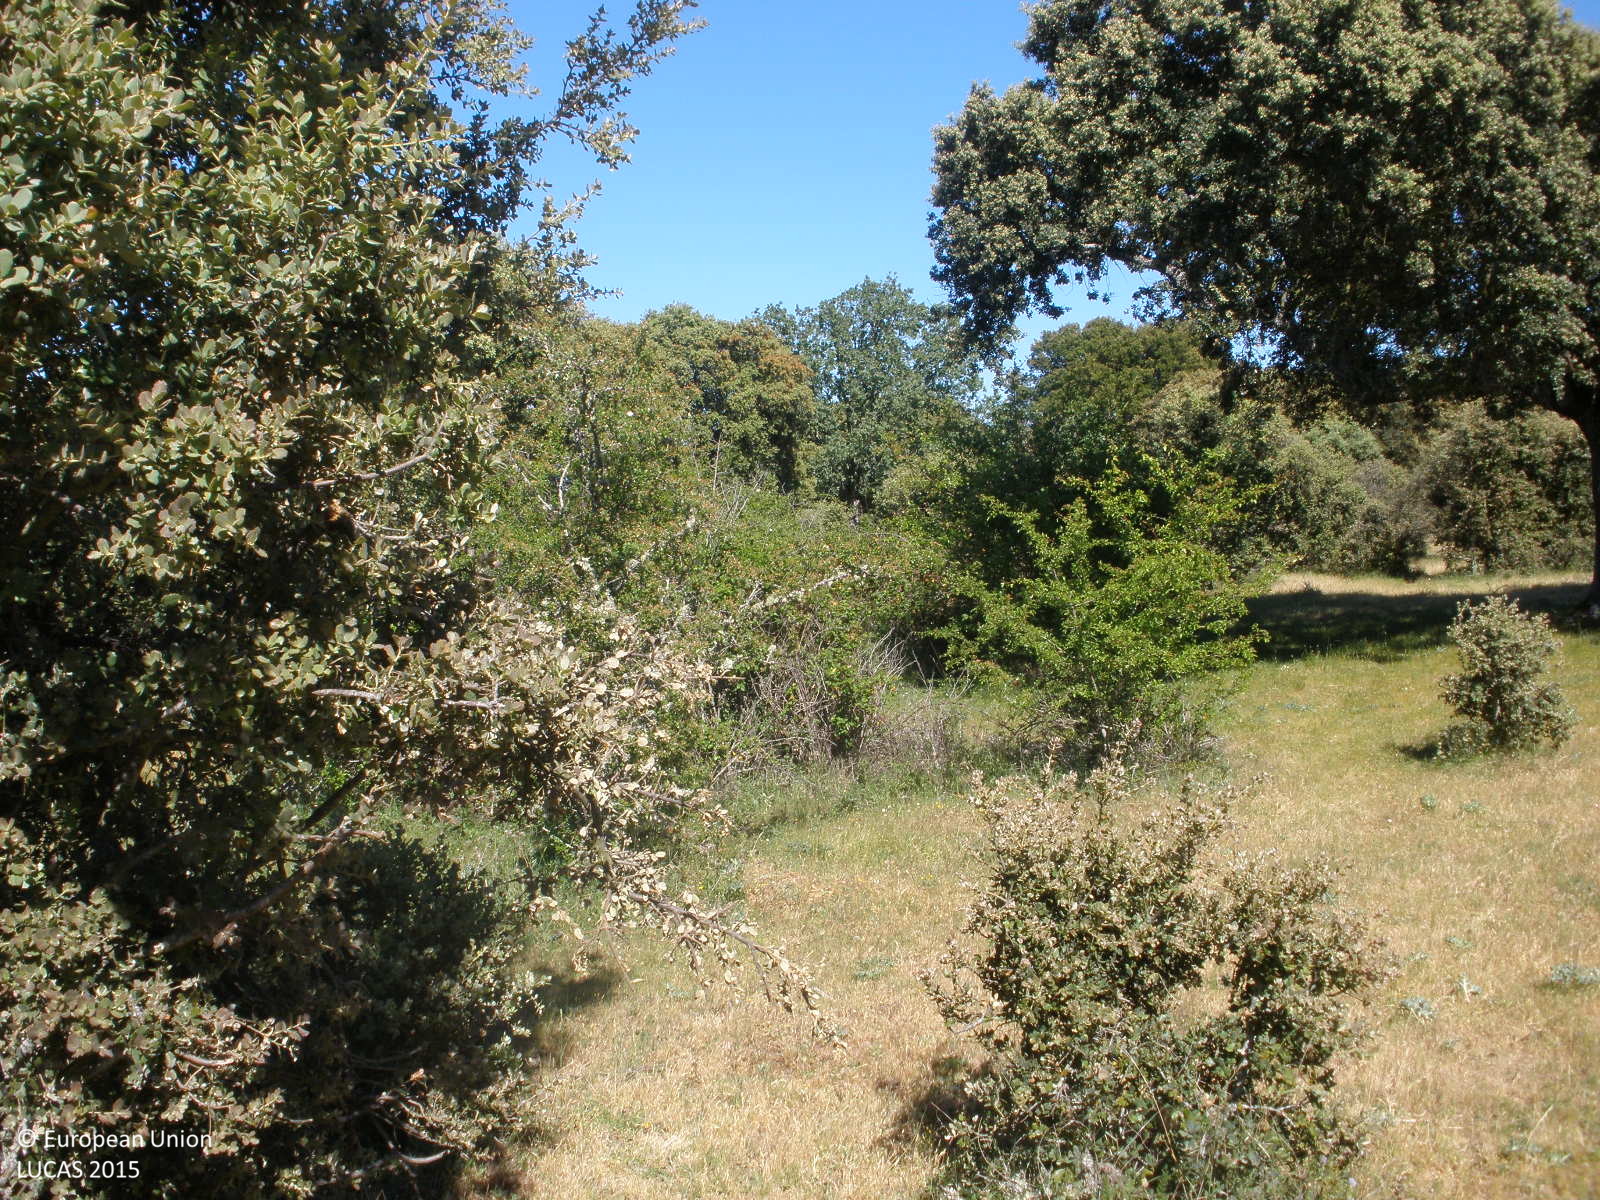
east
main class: Woodland
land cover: Broadleaved woodland
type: broadleaved evergreen forest
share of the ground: 25 - 50 %
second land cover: Grassland without tree/shrub cover
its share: > 75 %
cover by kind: herbaceous plants 50 %, broadleaved forest trees 30 %, shrubs 20 %
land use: Forestry
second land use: Agriculture (excluding fallow land and kitchen gardens)
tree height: < 5 m
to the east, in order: Broadleaved woodland; Grassland without tree/shrub cover
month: May
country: ES
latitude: 40.7333
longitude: -5.8617
